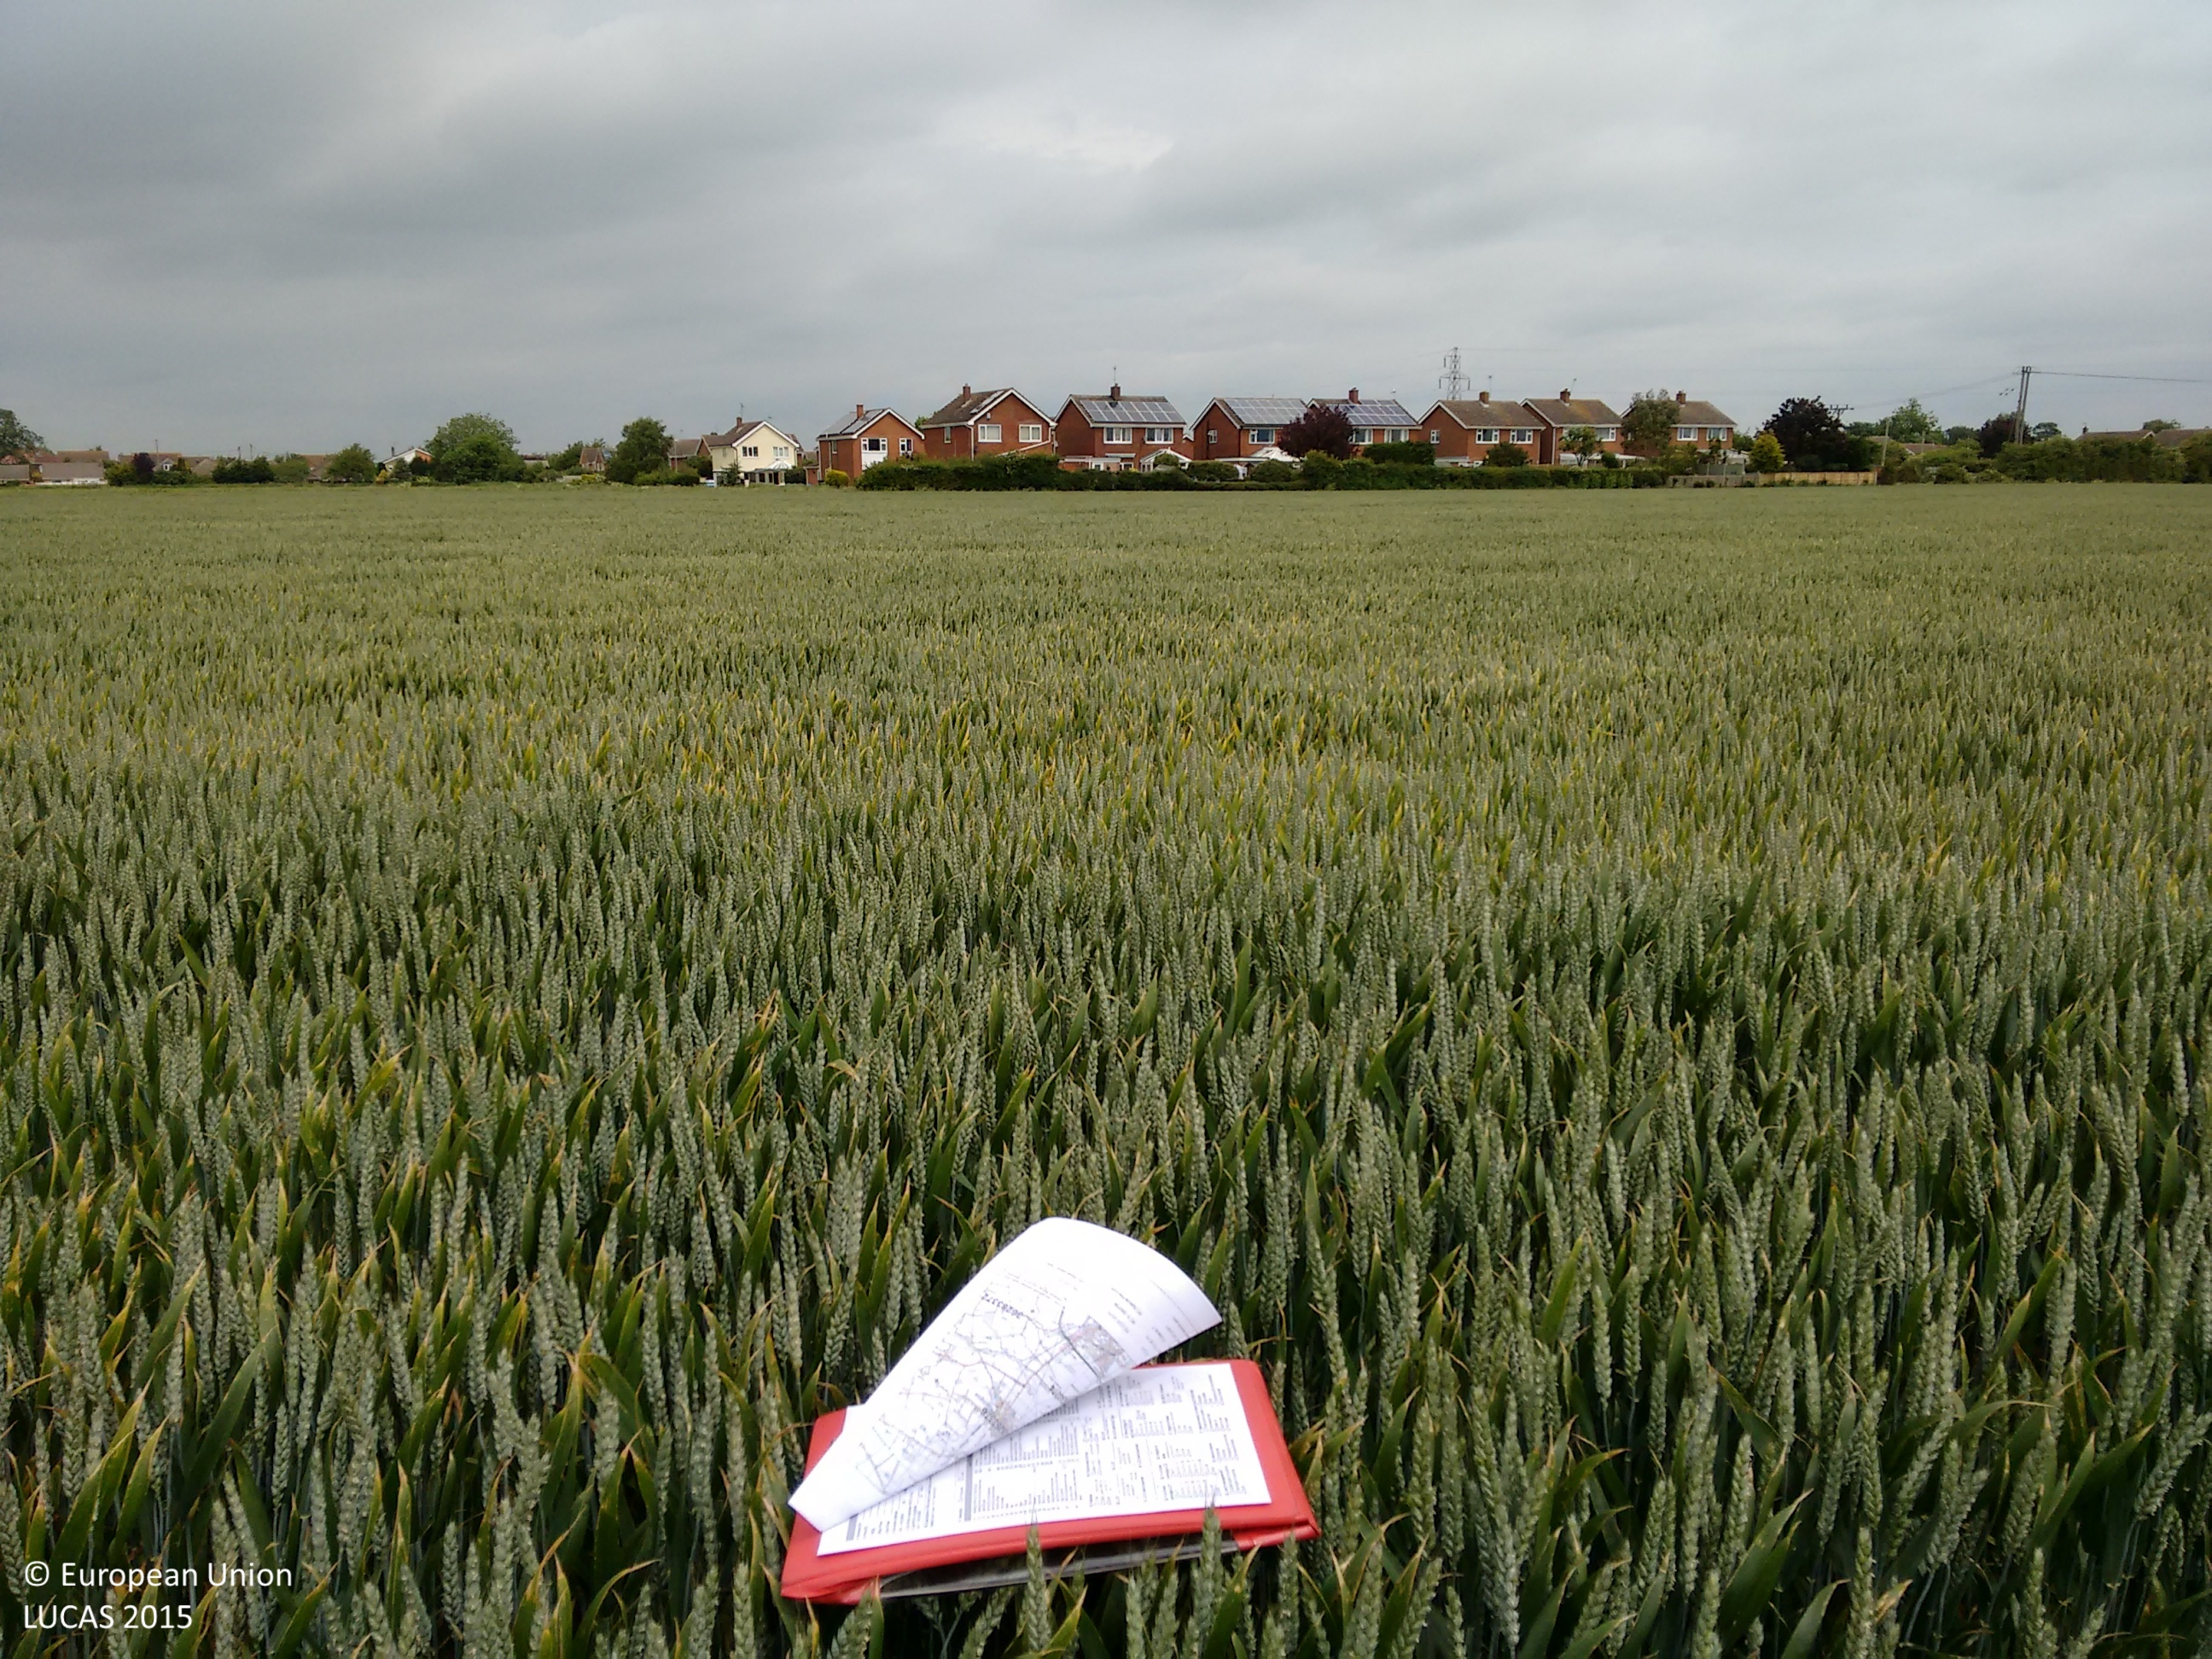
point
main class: Cropland
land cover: Common wheat
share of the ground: > 75 %
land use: Agriculture (excluding fallow land and kitchen gardens)
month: June
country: GB
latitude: 53.0433
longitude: -0.4029
